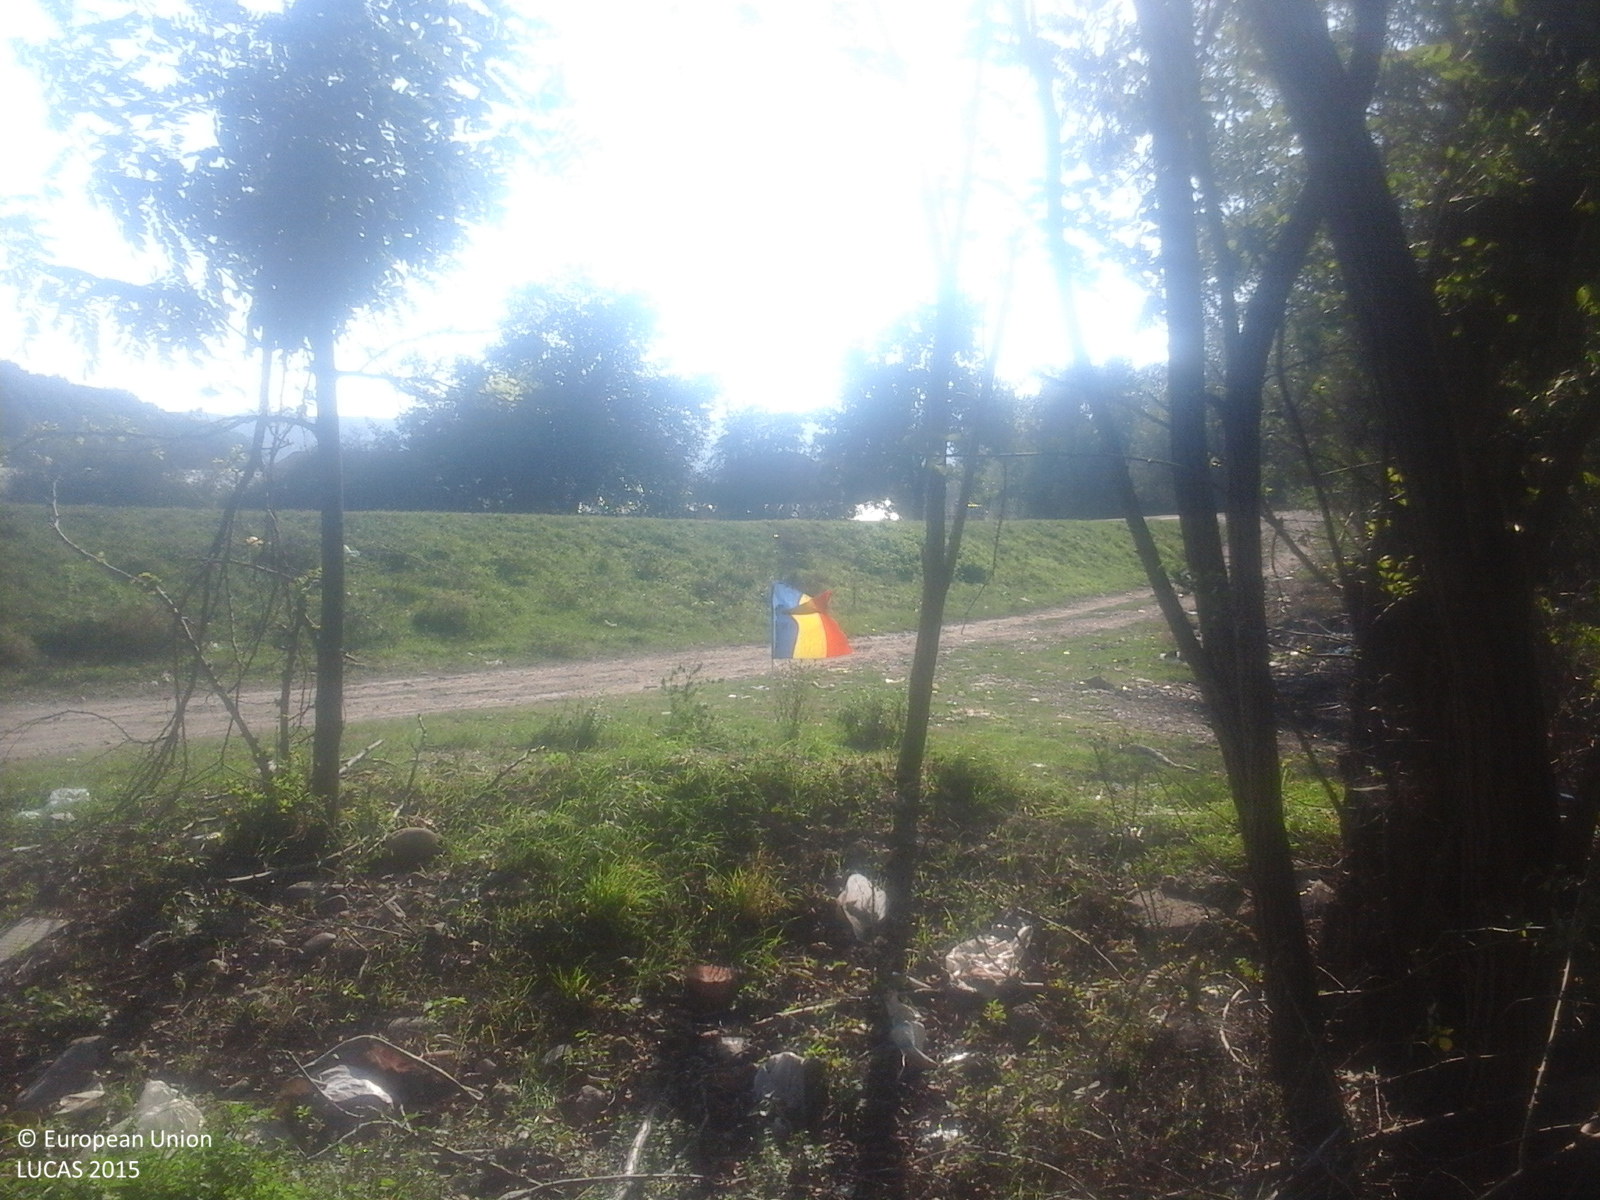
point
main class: Woodland
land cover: Broadleaved woodland
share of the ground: > 75 %
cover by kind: broadleaved forest trees 100 %
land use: Forestry
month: September
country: RO
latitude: 46.6319
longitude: 22.3676
